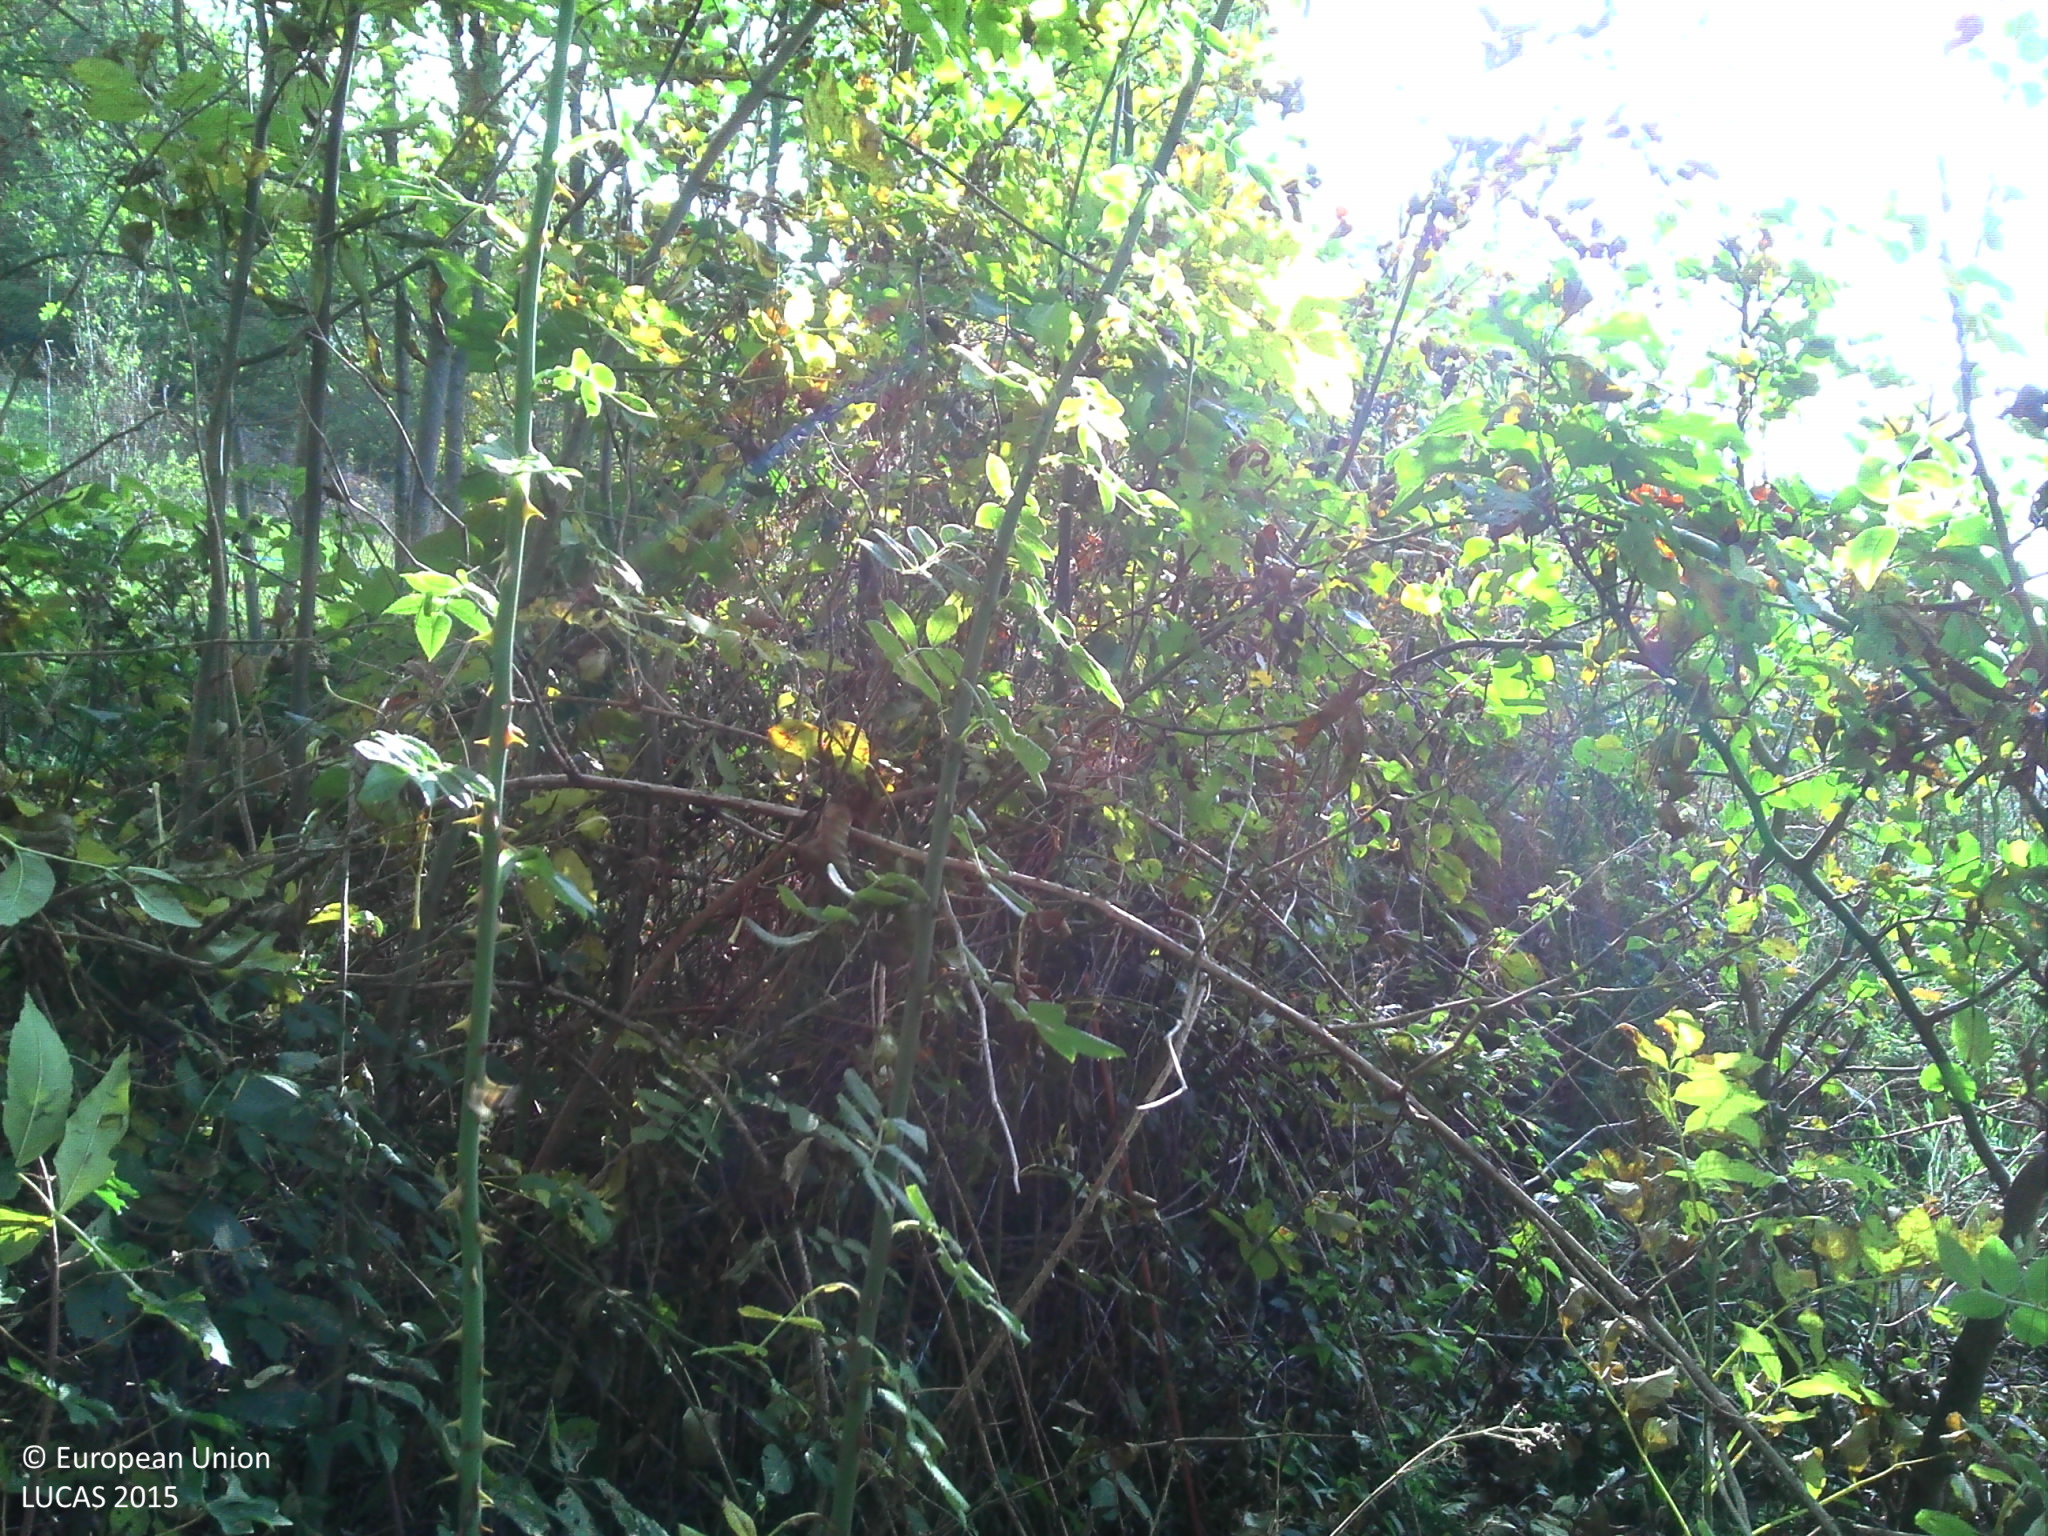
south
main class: Woodland
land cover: Broadleaved woodland
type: mesophytic deciduous forest
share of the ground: > 75 %
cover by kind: broadleaved forest trees 90 %, shrubs 5 %, consolidated bare surface 5 %
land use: Forestry
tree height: > 5 m
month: October
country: FR
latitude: 45.4031
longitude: 6.2871
